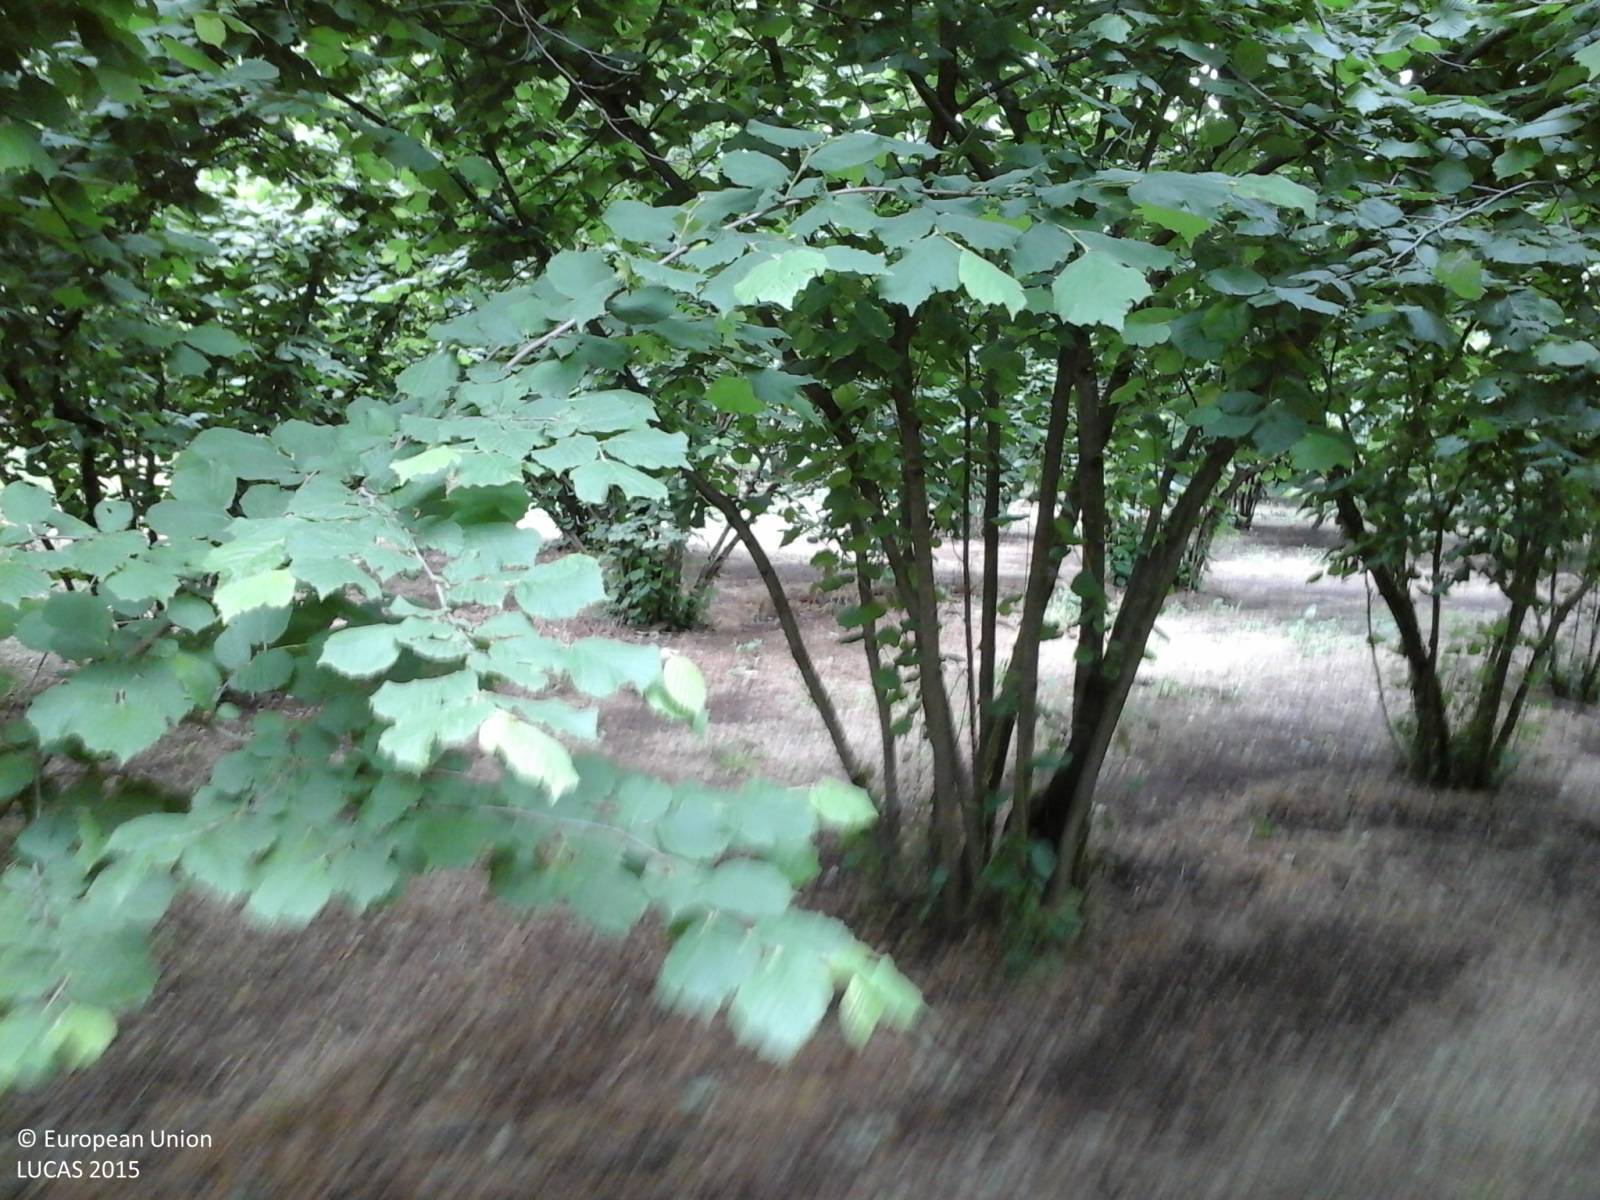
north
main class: Cropland
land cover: Nuts trees
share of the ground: > 75 %
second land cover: Spontaneously vegetated surfaces
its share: 50 - 75 %
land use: Agriculture (excluding fallow land and kitchen gardens)
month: May
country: IT
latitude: 42.3041
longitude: 12.2364
